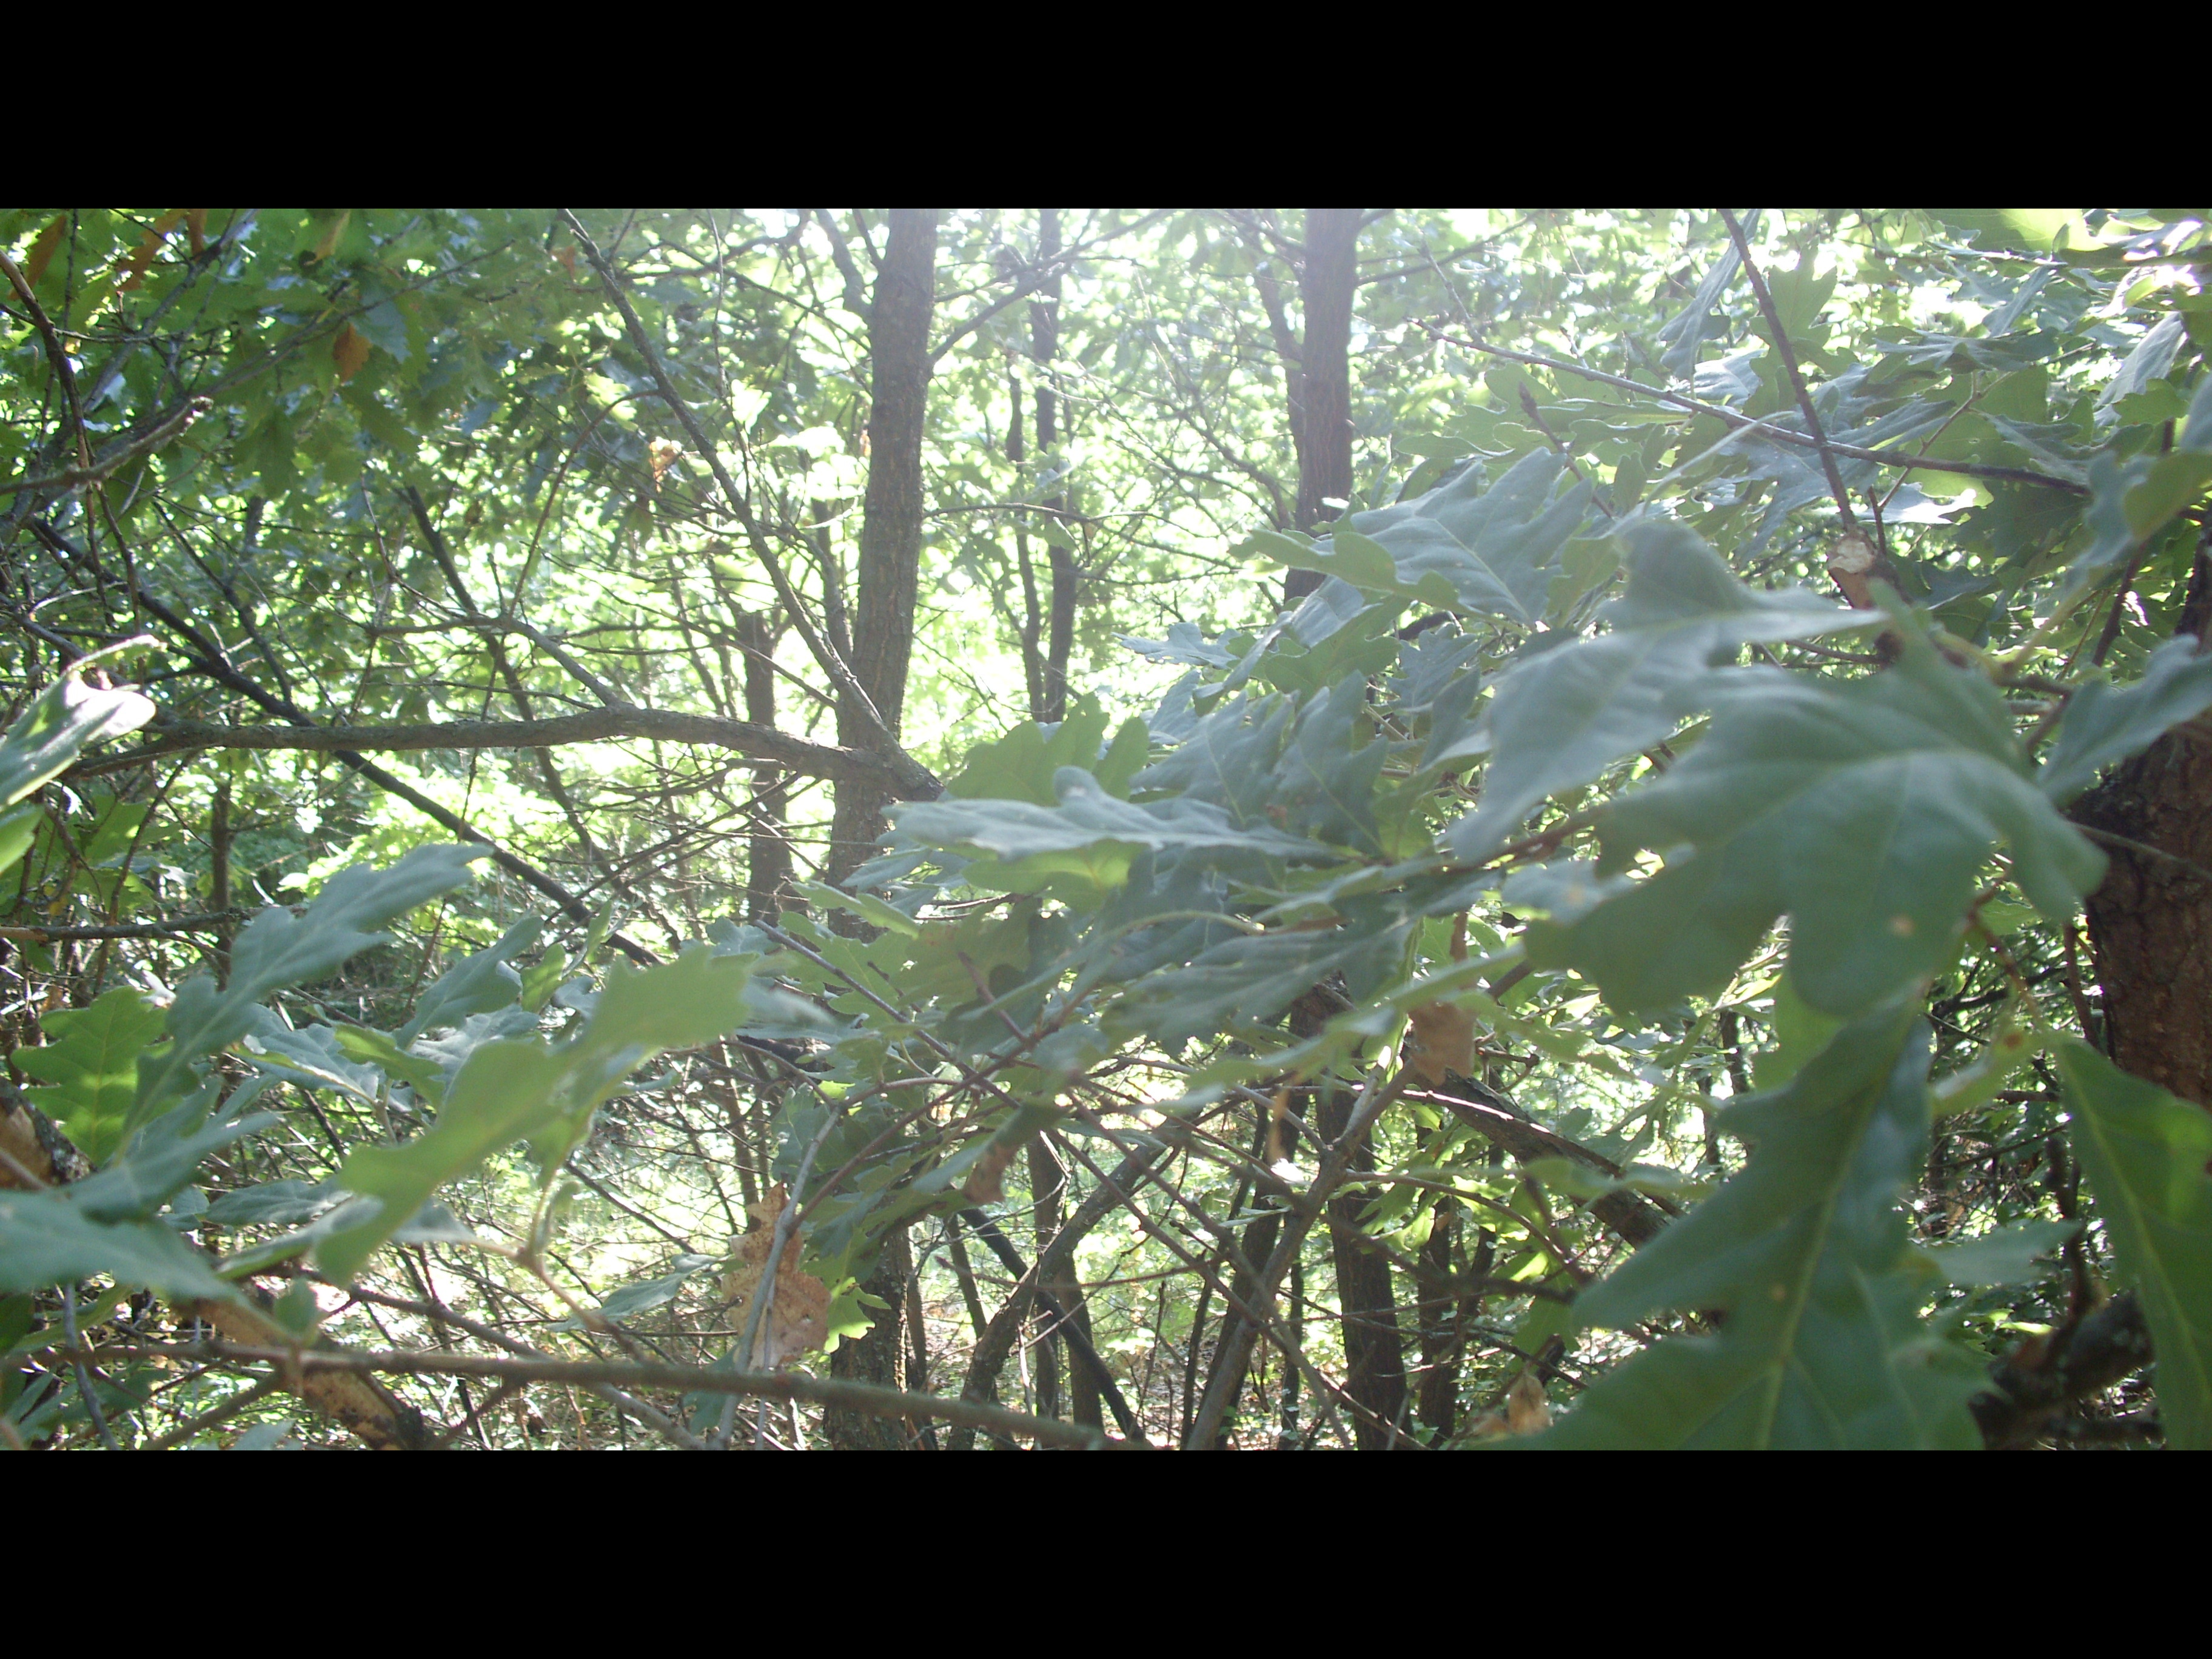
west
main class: Woodland
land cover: Broadleaved woodland
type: mesophytic deciduous forest
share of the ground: > 75 %
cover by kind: broadleaved forest trees 95 %, shrubs 5 %
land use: Forestry
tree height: > 5 m
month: June
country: BG
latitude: 43.4776
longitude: 23.5329
